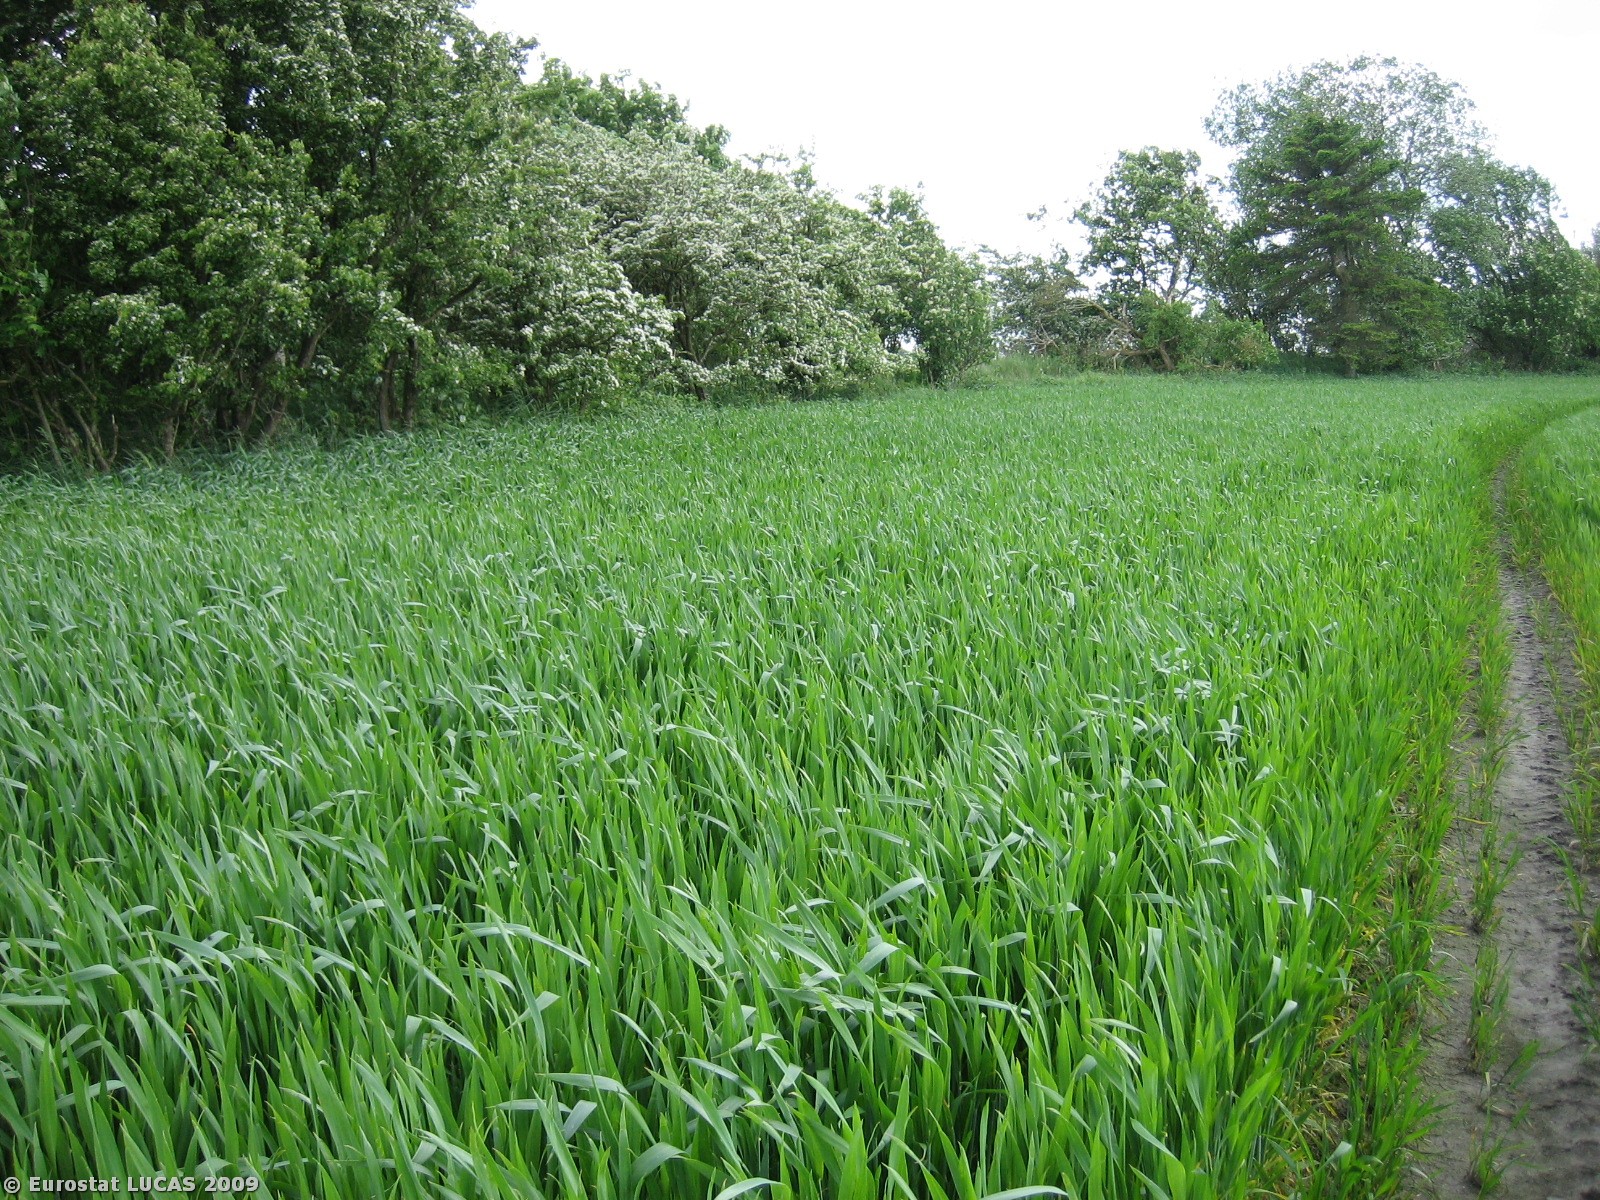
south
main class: Cropland
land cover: Barley
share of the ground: > 75 %
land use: Agriculture (excluding fallow land and kitchen gardens)
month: May
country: DK
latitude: 56.0212
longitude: 8.8942
